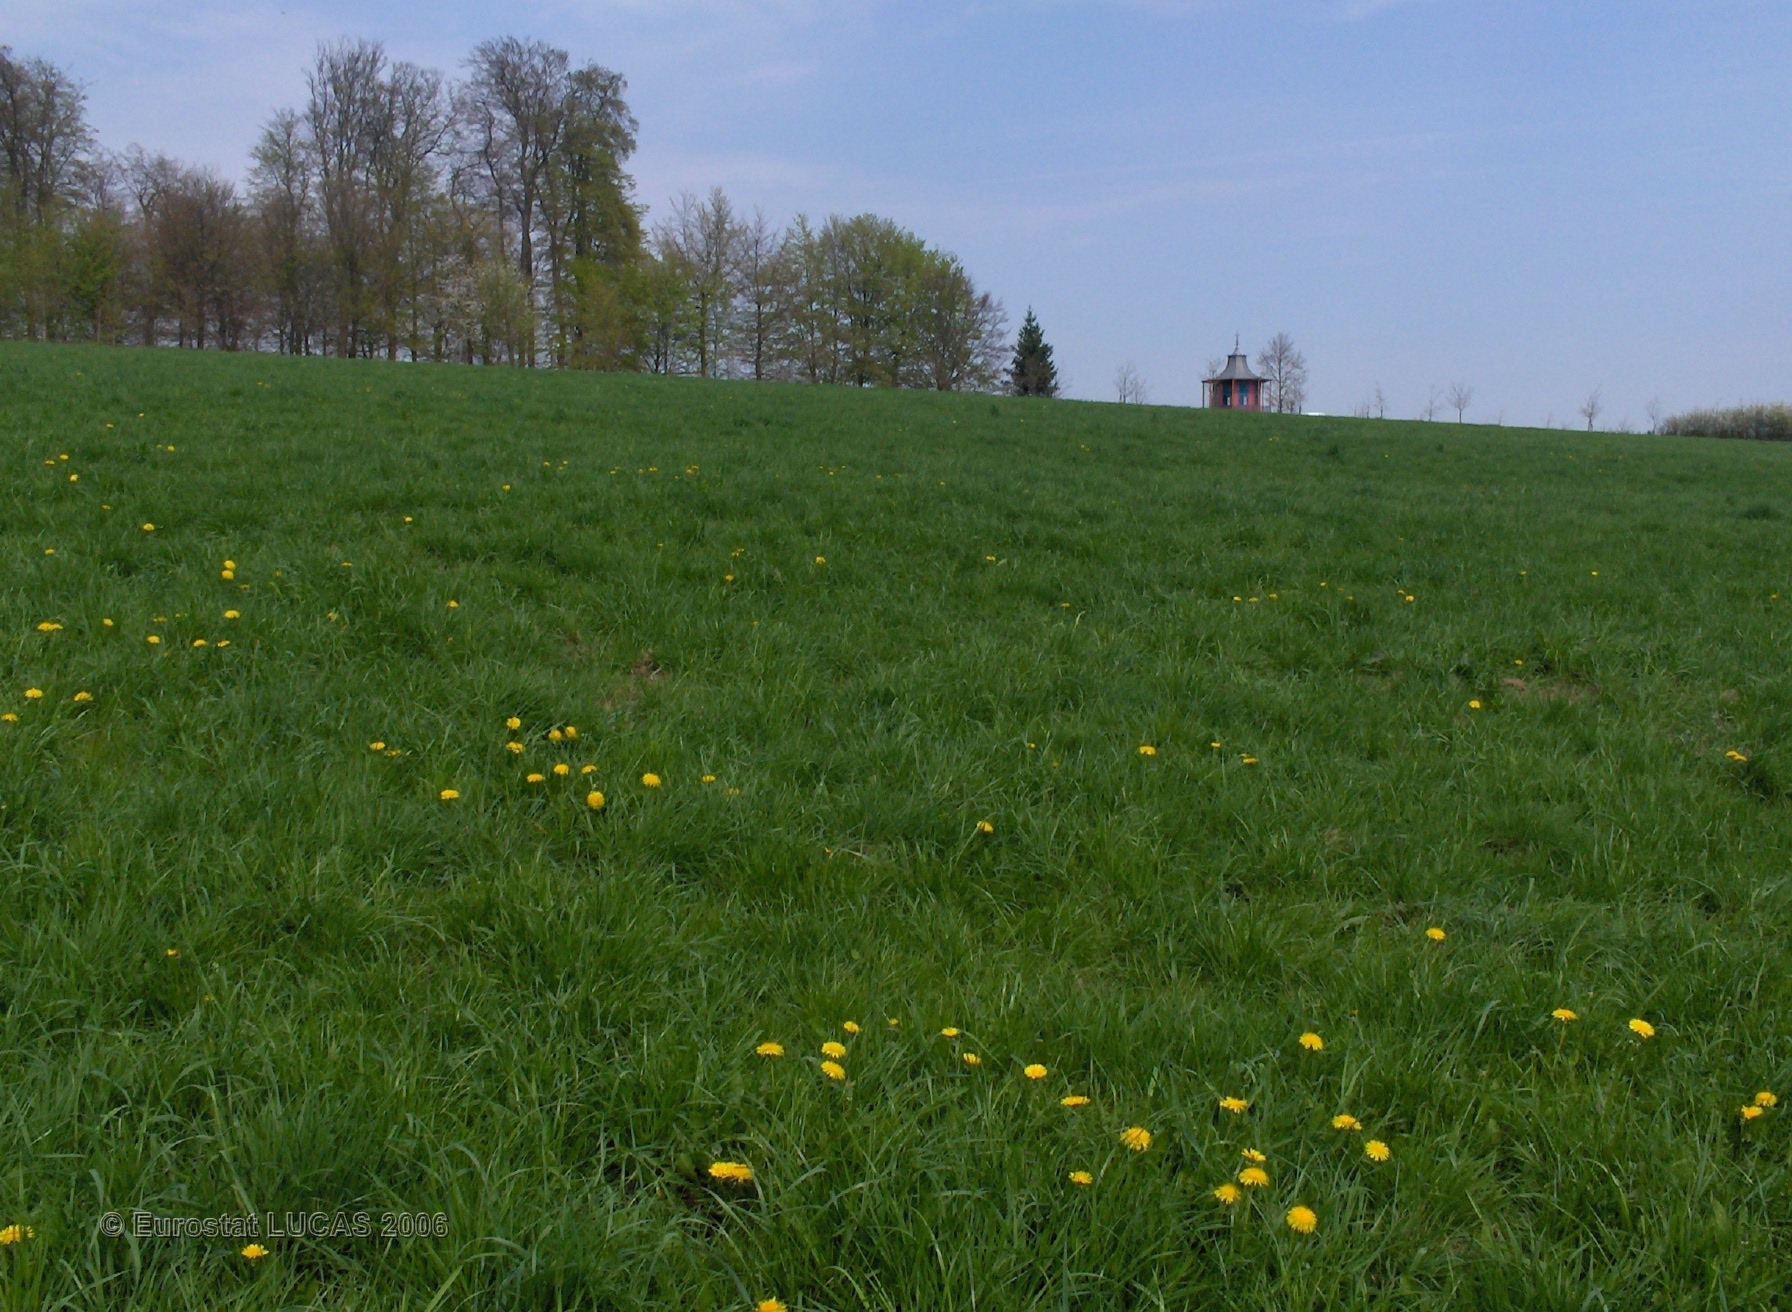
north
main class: Grassland
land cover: Grassland without tree/shrub cover
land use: Agriculture (excluding fallow land and kitchen gardens)
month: May
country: BE
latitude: 50.3212
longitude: 5.2927
